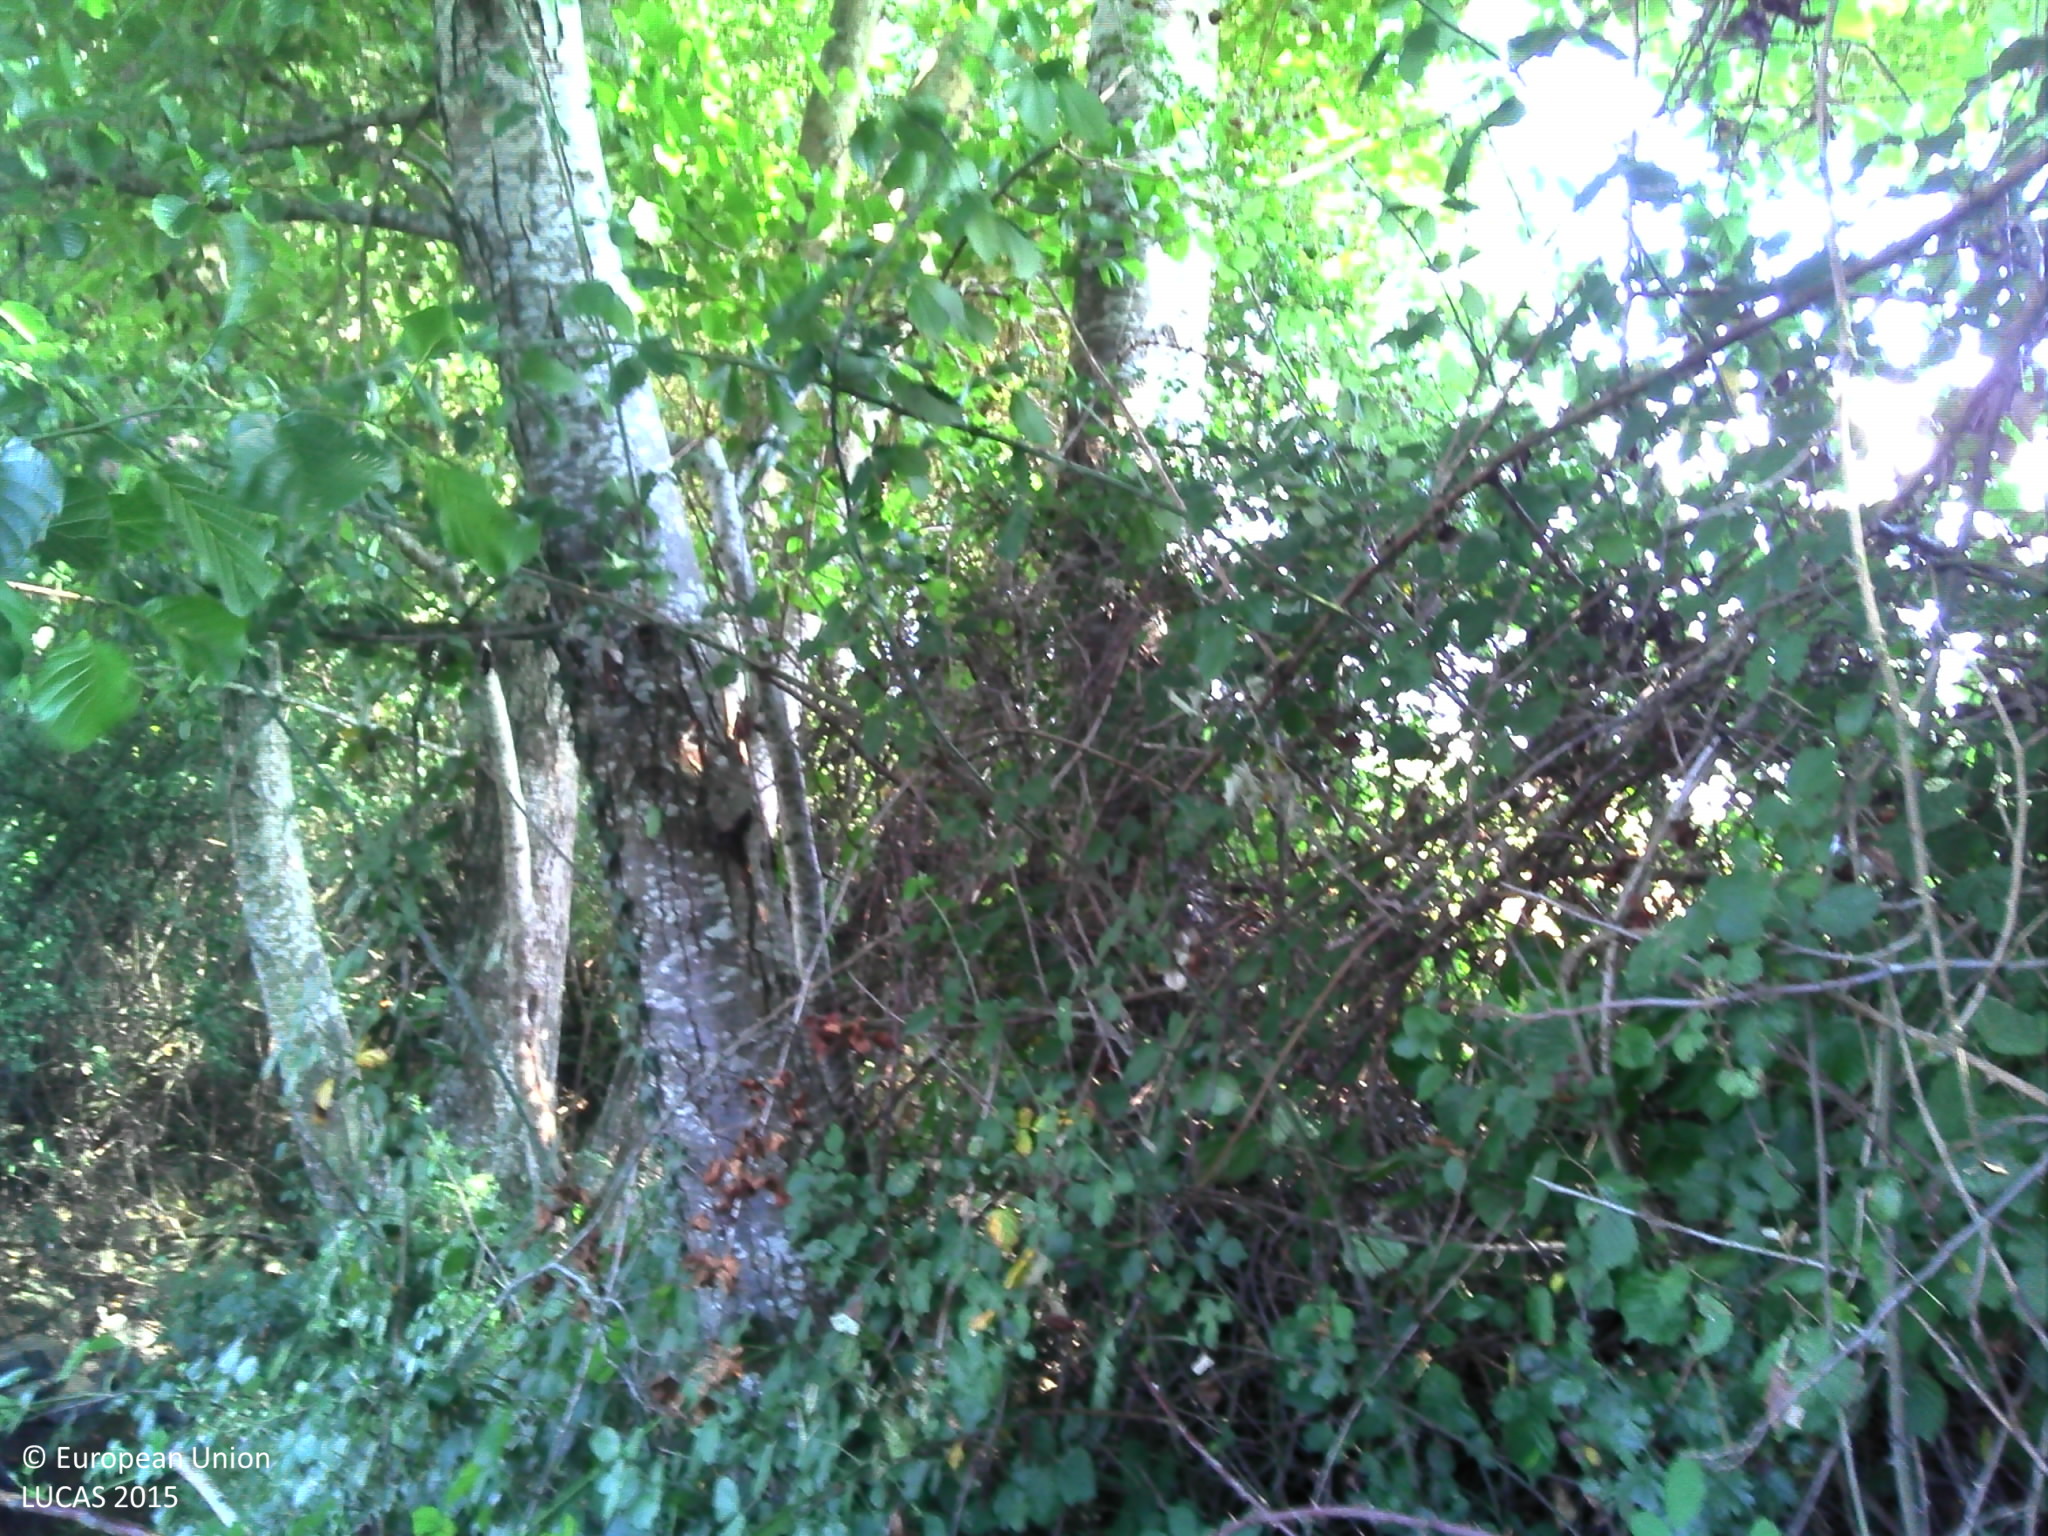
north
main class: Woodland
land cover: Broadleaved woodland
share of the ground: > 75 %
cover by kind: broadleaved forest trees 90 %, shrubs 10 %
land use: Agriculture (excluding fallow land and kitchen gardens)
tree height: > 5 m
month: July
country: FR
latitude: 46.5352
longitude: 2.1832
